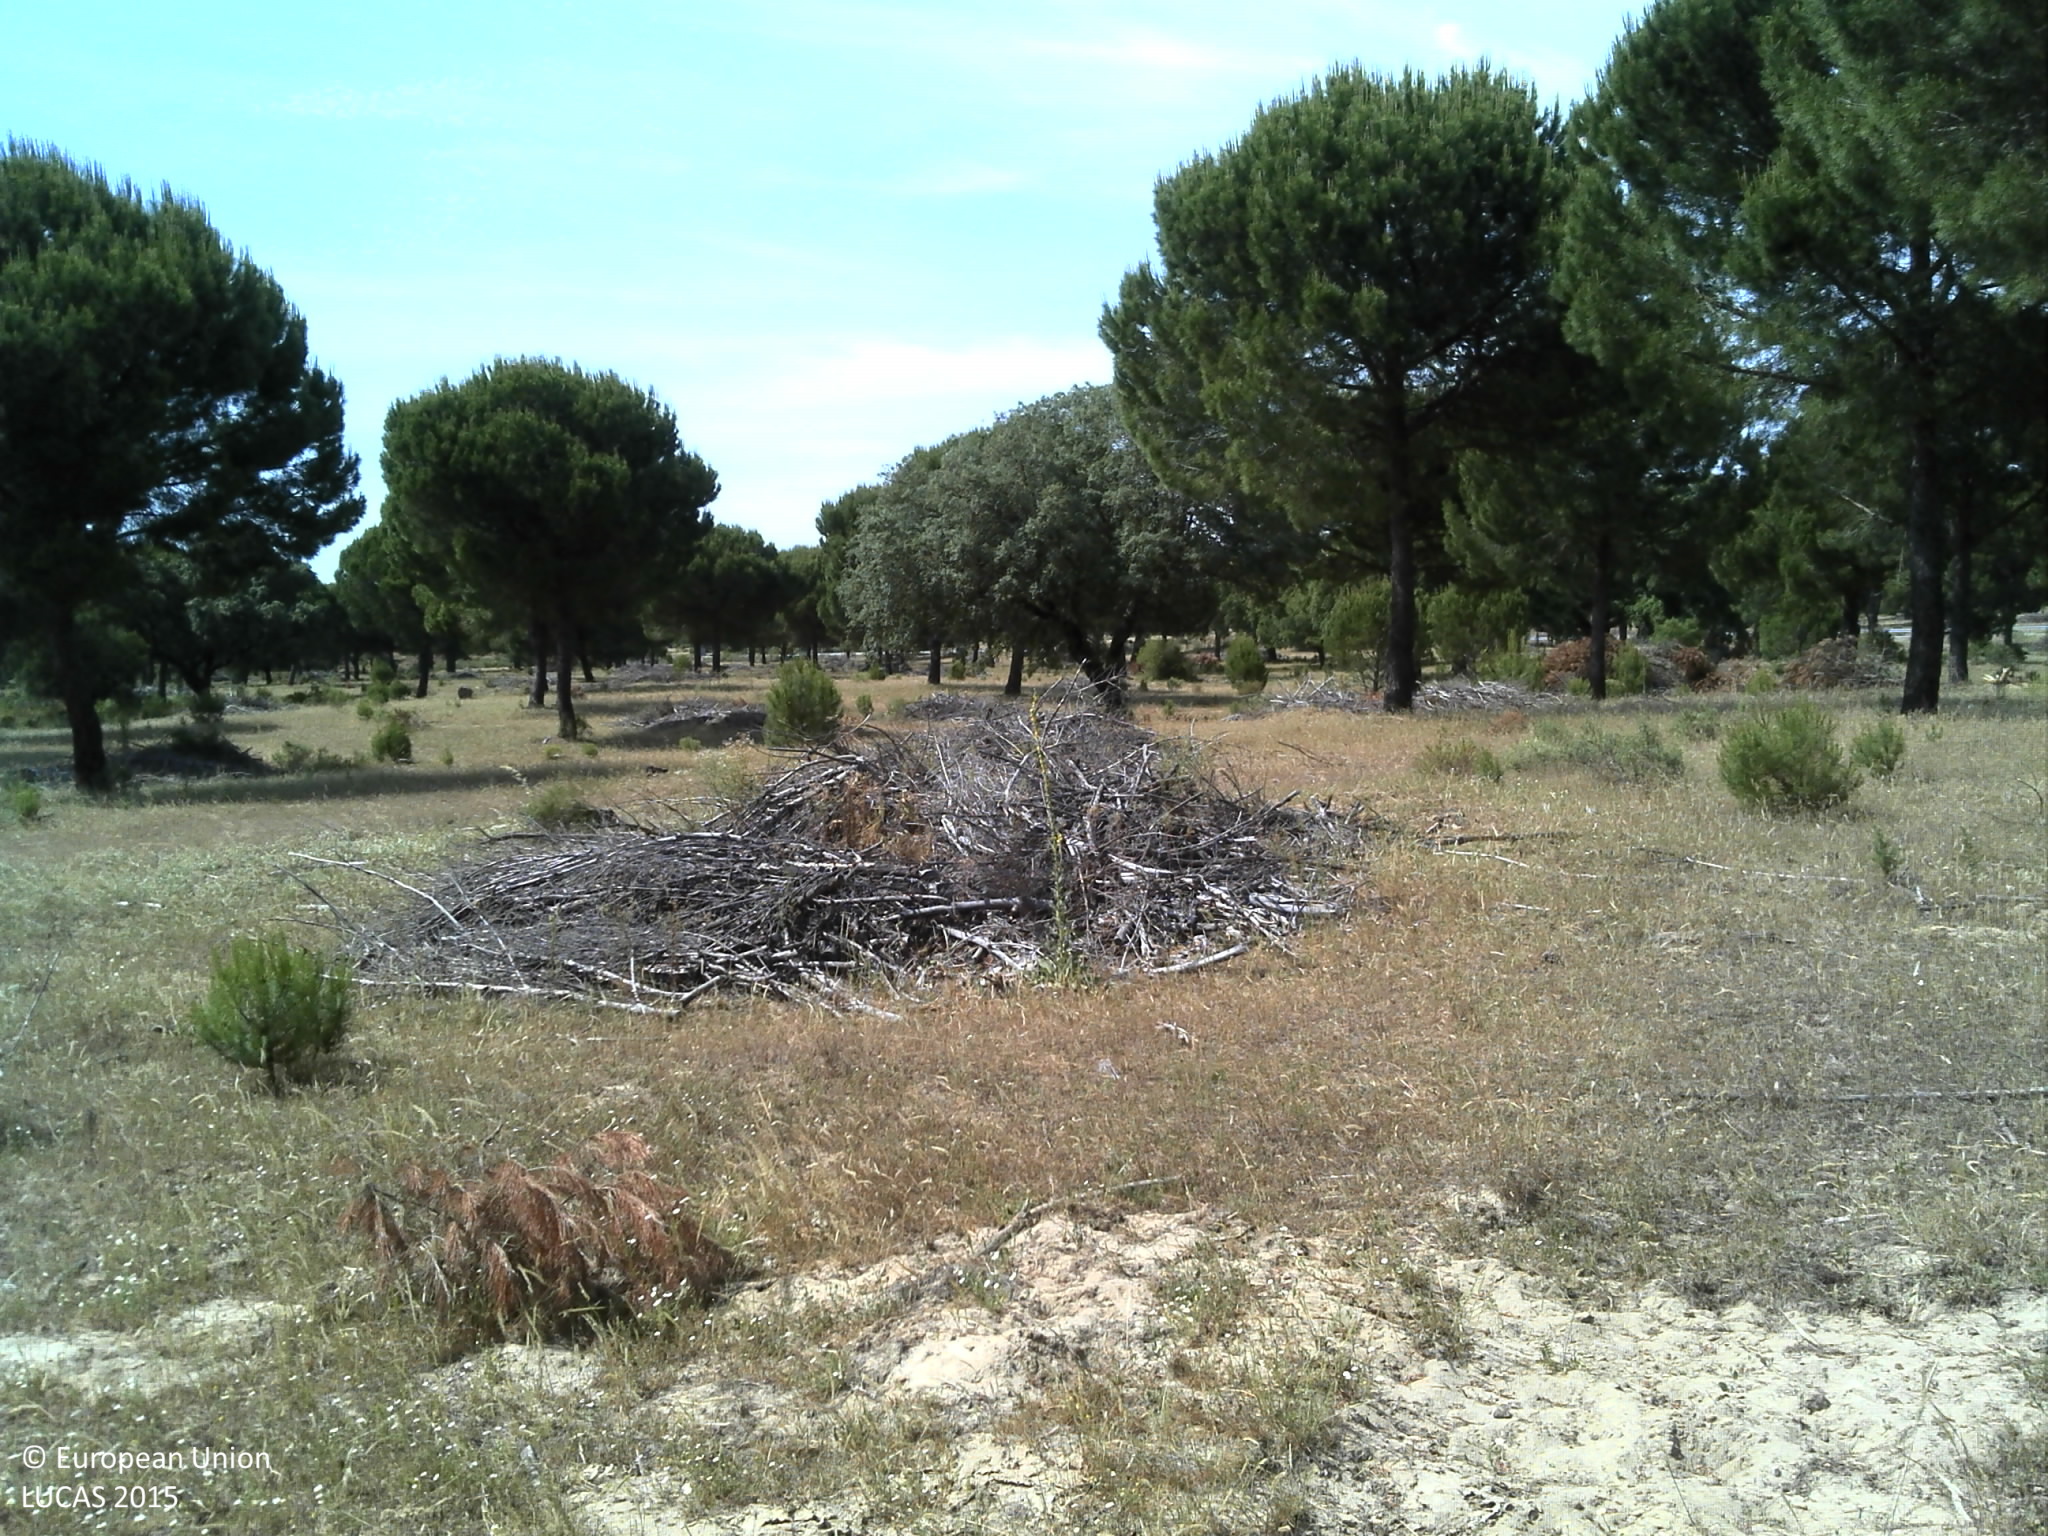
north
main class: Woodland
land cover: Pine dominated coniferous woodland
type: coniferous forest of the mediterranean region
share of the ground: 10 - 25 %
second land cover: Grassland without tree/shrub cover
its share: 10 - 25 %
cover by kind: unconsolidated bare surface 50 %, coniferous forest trees 25 %, herbaceous plants 25 %
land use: Forestry
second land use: Agriculture (excluding fallow land and kitchen gardens)
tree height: > 5 m
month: May
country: PT
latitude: 38.0605
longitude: -8.3327
